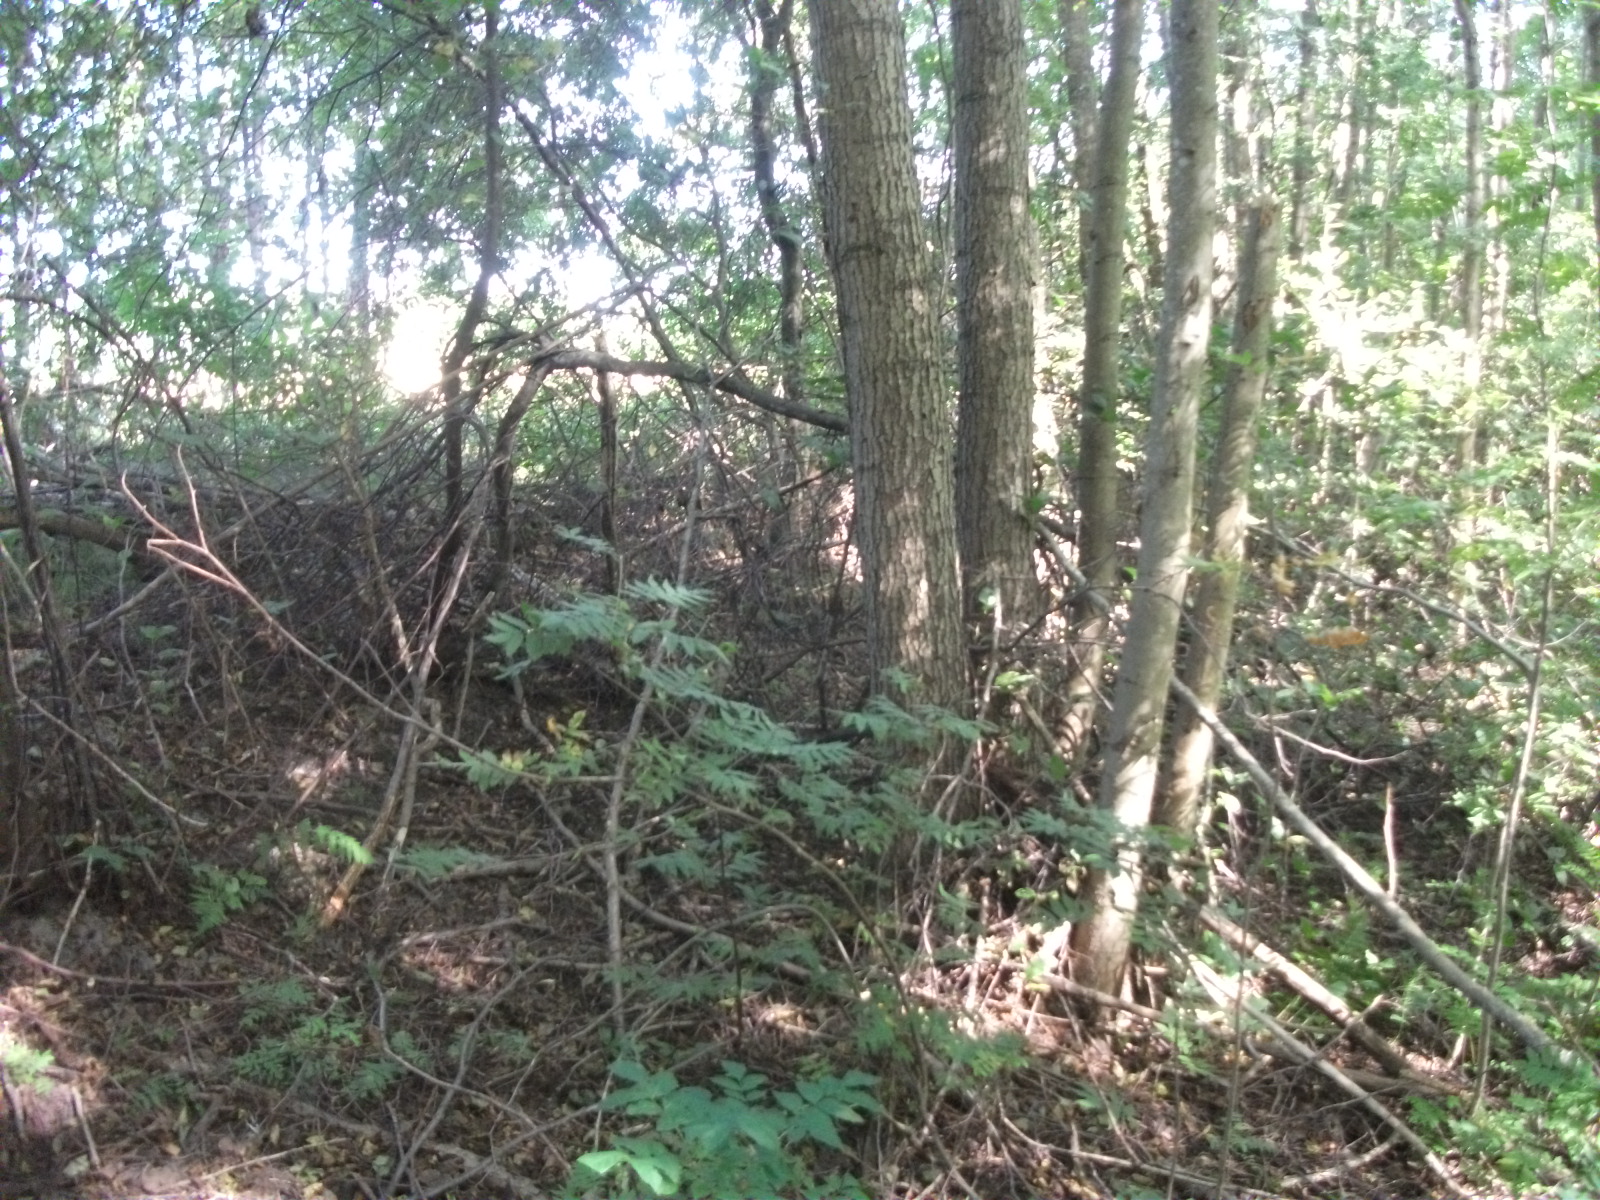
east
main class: Woodland
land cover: Broadleaved woodland
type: non-riverine alder, birch or aspen forest
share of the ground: > 75 %
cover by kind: broadleaved forest trees 95 %, shrubs 5 %
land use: Forestry
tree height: > 5 m
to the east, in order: Broadleaved woodland; Durum wheat; Grass margins; Tracks; Grassland without tree/shrub cover; Broadleaved woodland; Grassland without tree/shrub cover; Broadleaved woodland
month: August
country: LV
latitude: 56.5237
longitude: 26.0823
